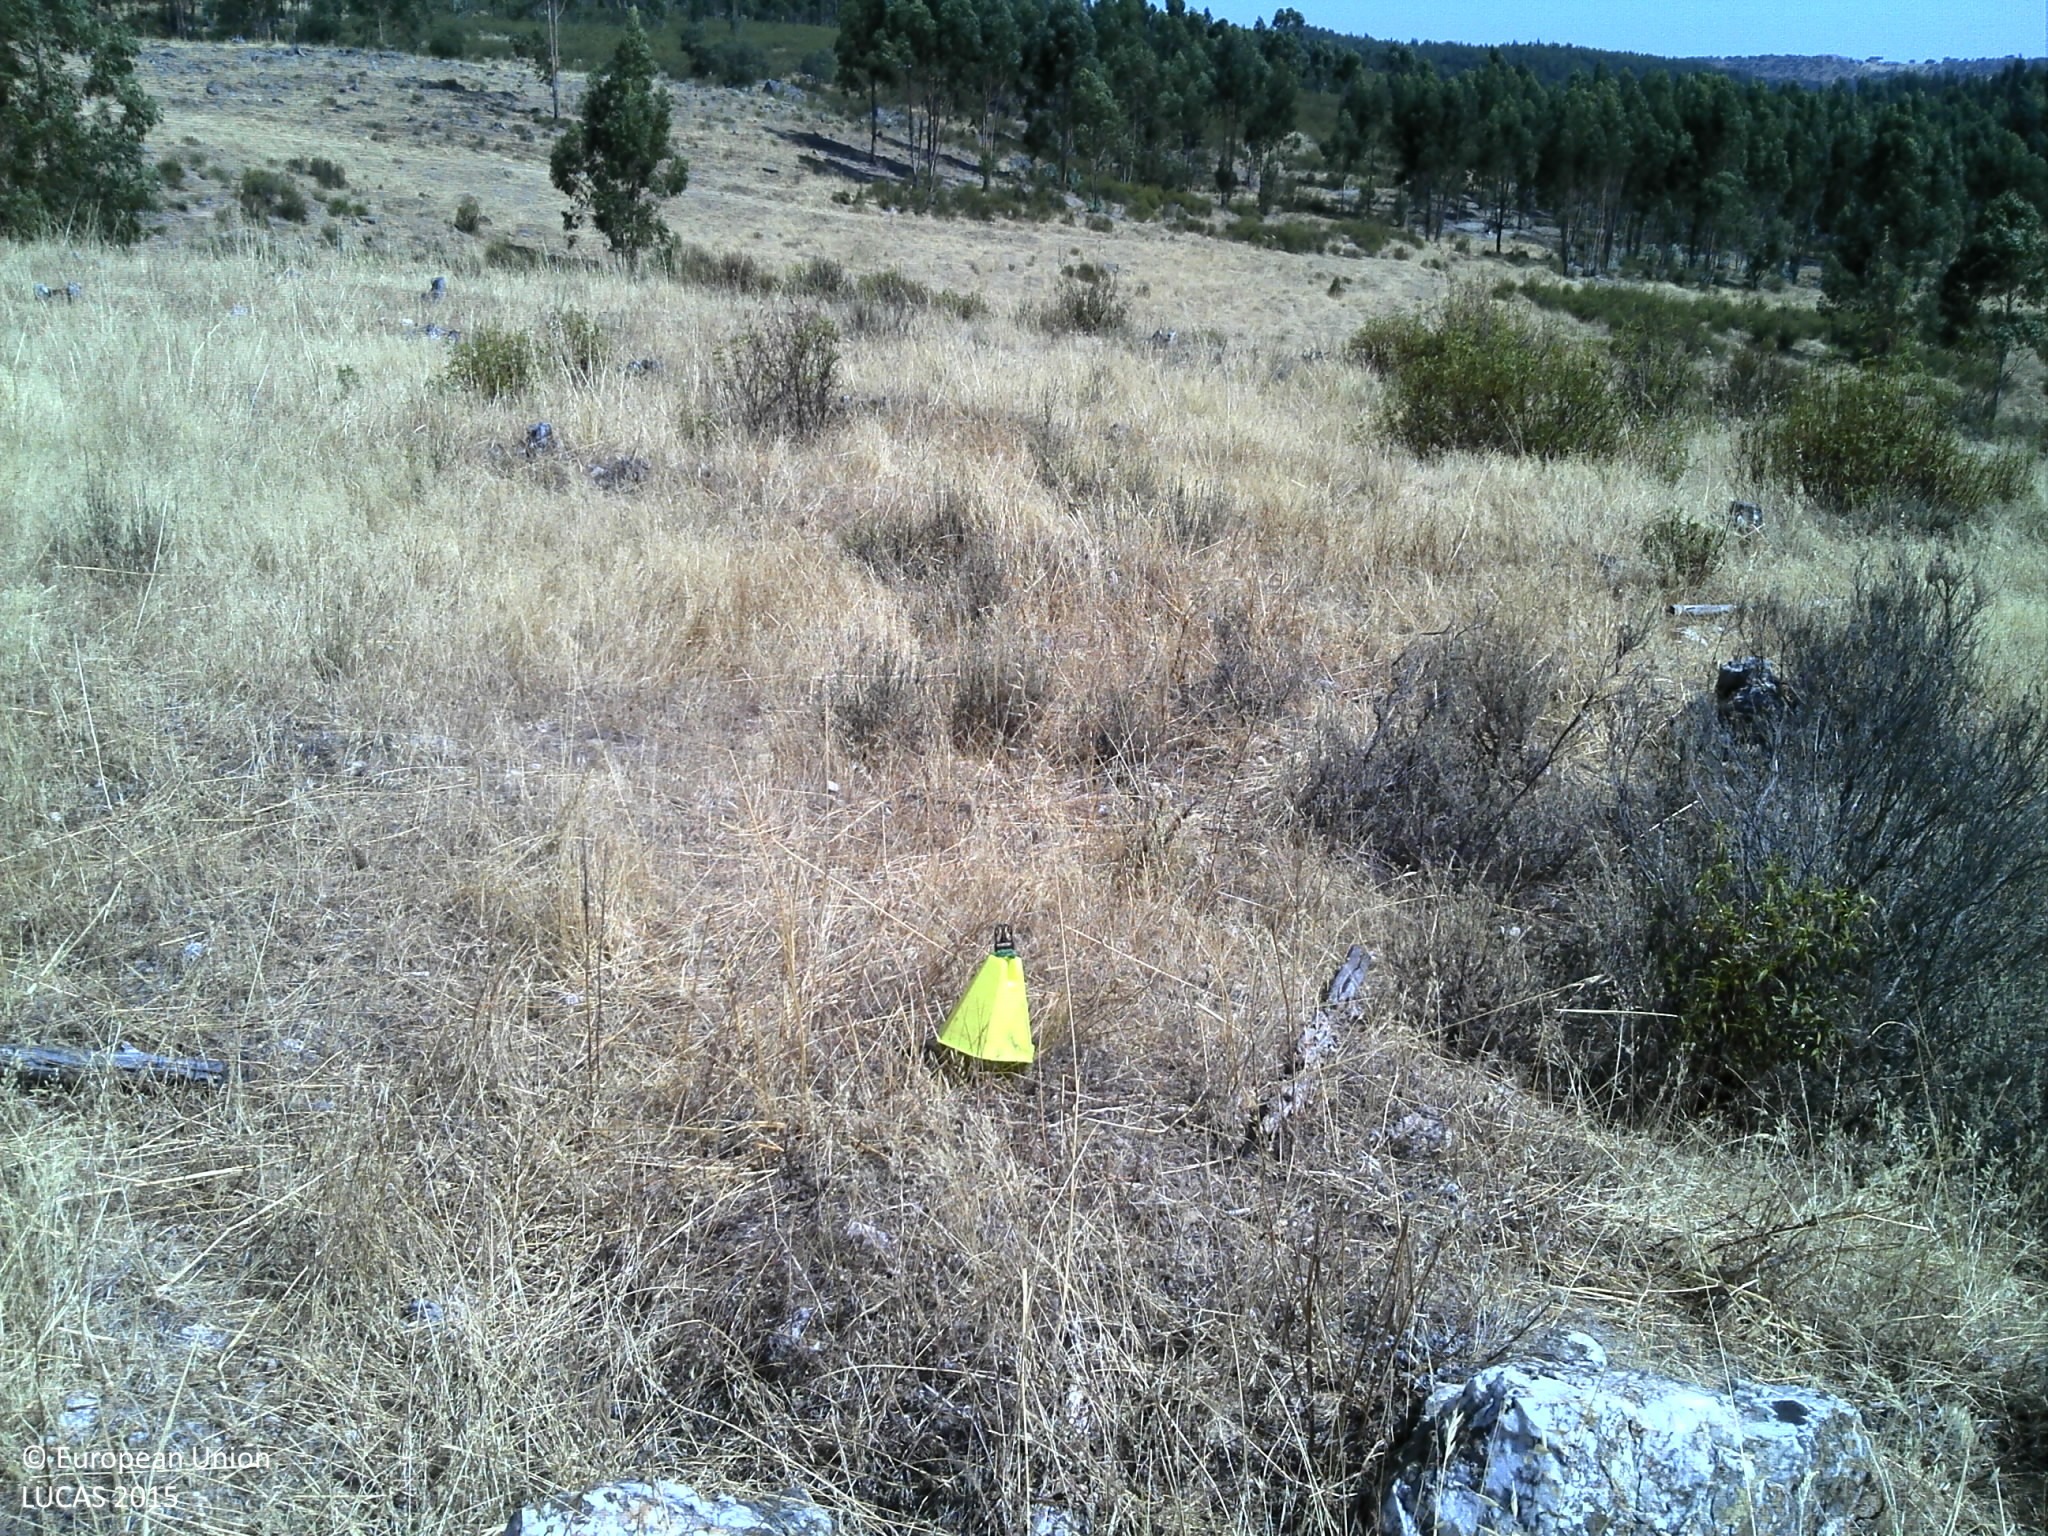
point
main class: Shrubland
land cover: Shrubland without tree cover
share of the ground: 25 - 50 %
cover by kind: herbaceous plants 60 %, shrubs 25 %, unconsolidated bare surface 15 %
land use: Agriculture (excluding fallow land and kitchen gardens)
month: July
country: PT
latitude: 38.6642
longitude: -7.4885
